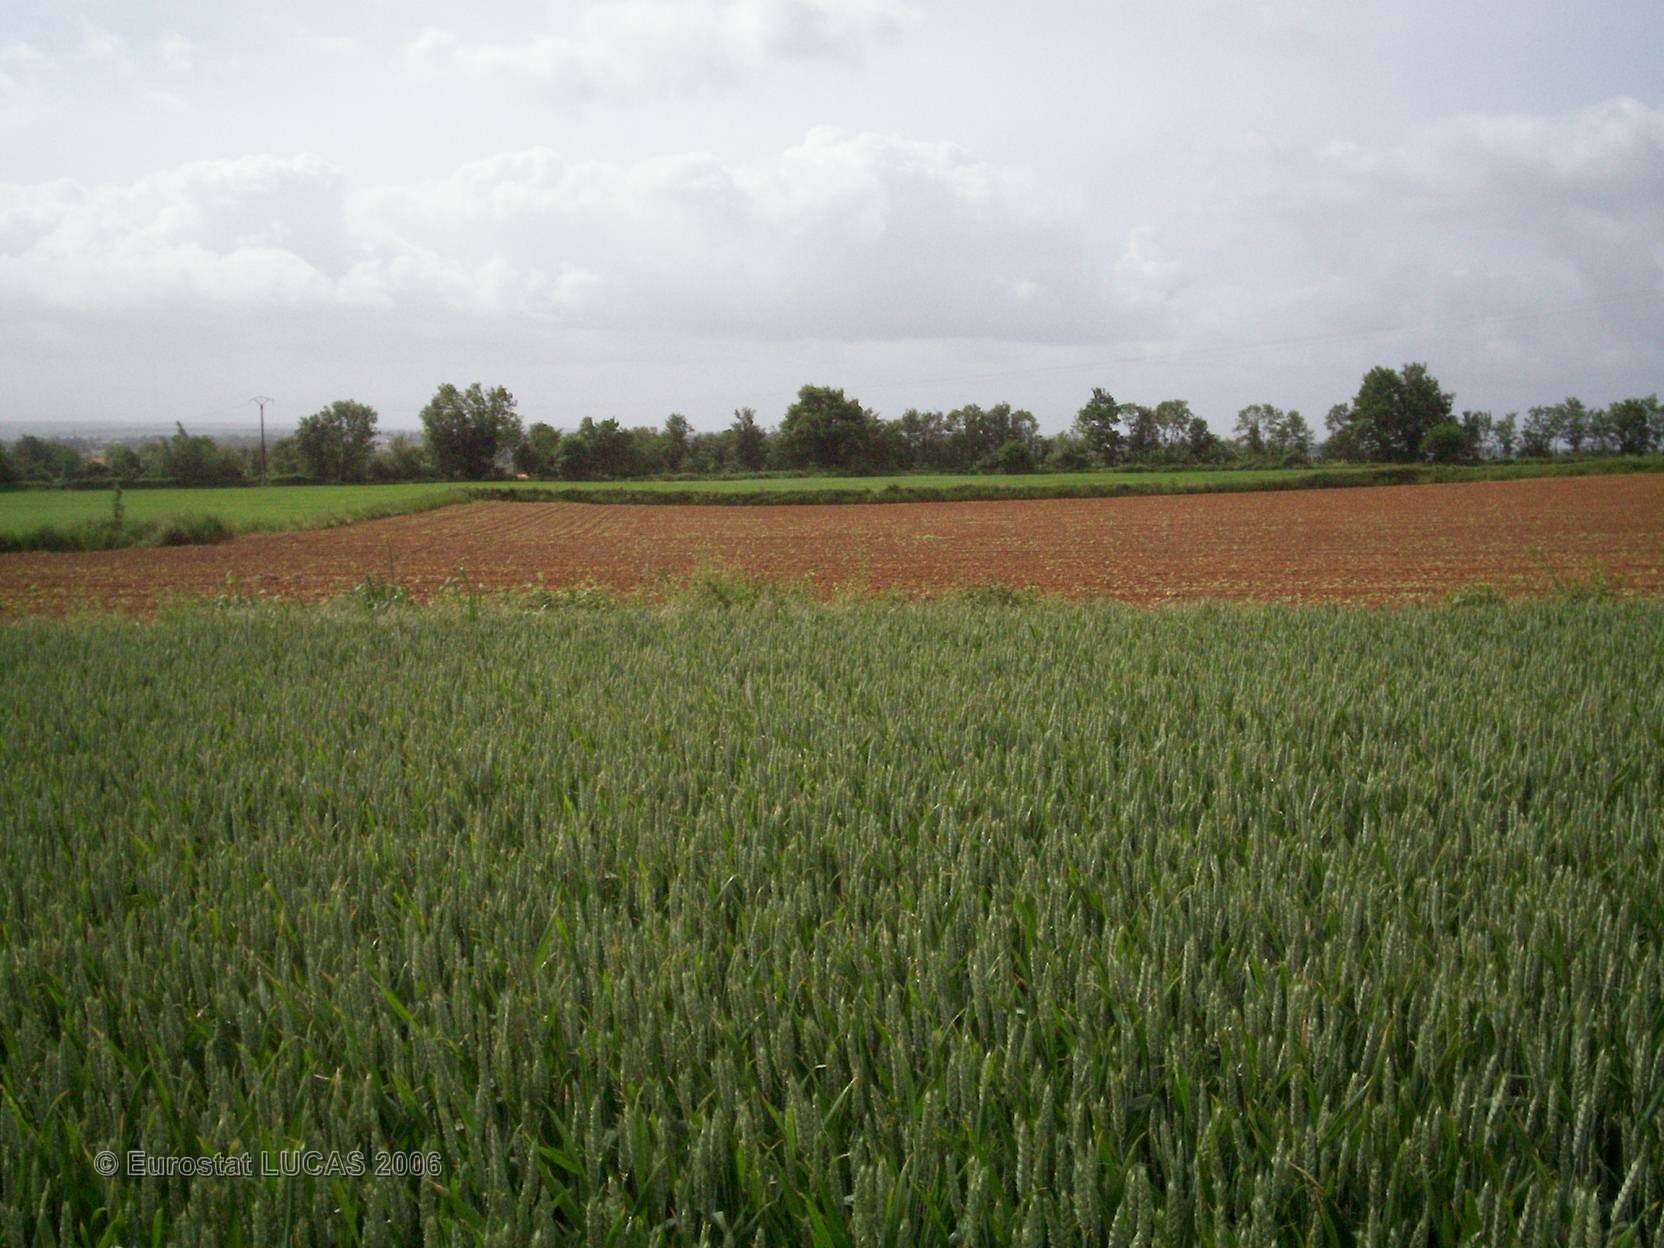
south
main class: Cropland
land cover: Common wheat
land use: Agriculture (excluding fallow land and kitchen gardens)
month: May
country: FR
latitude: 46.4391
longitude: -0.2411
